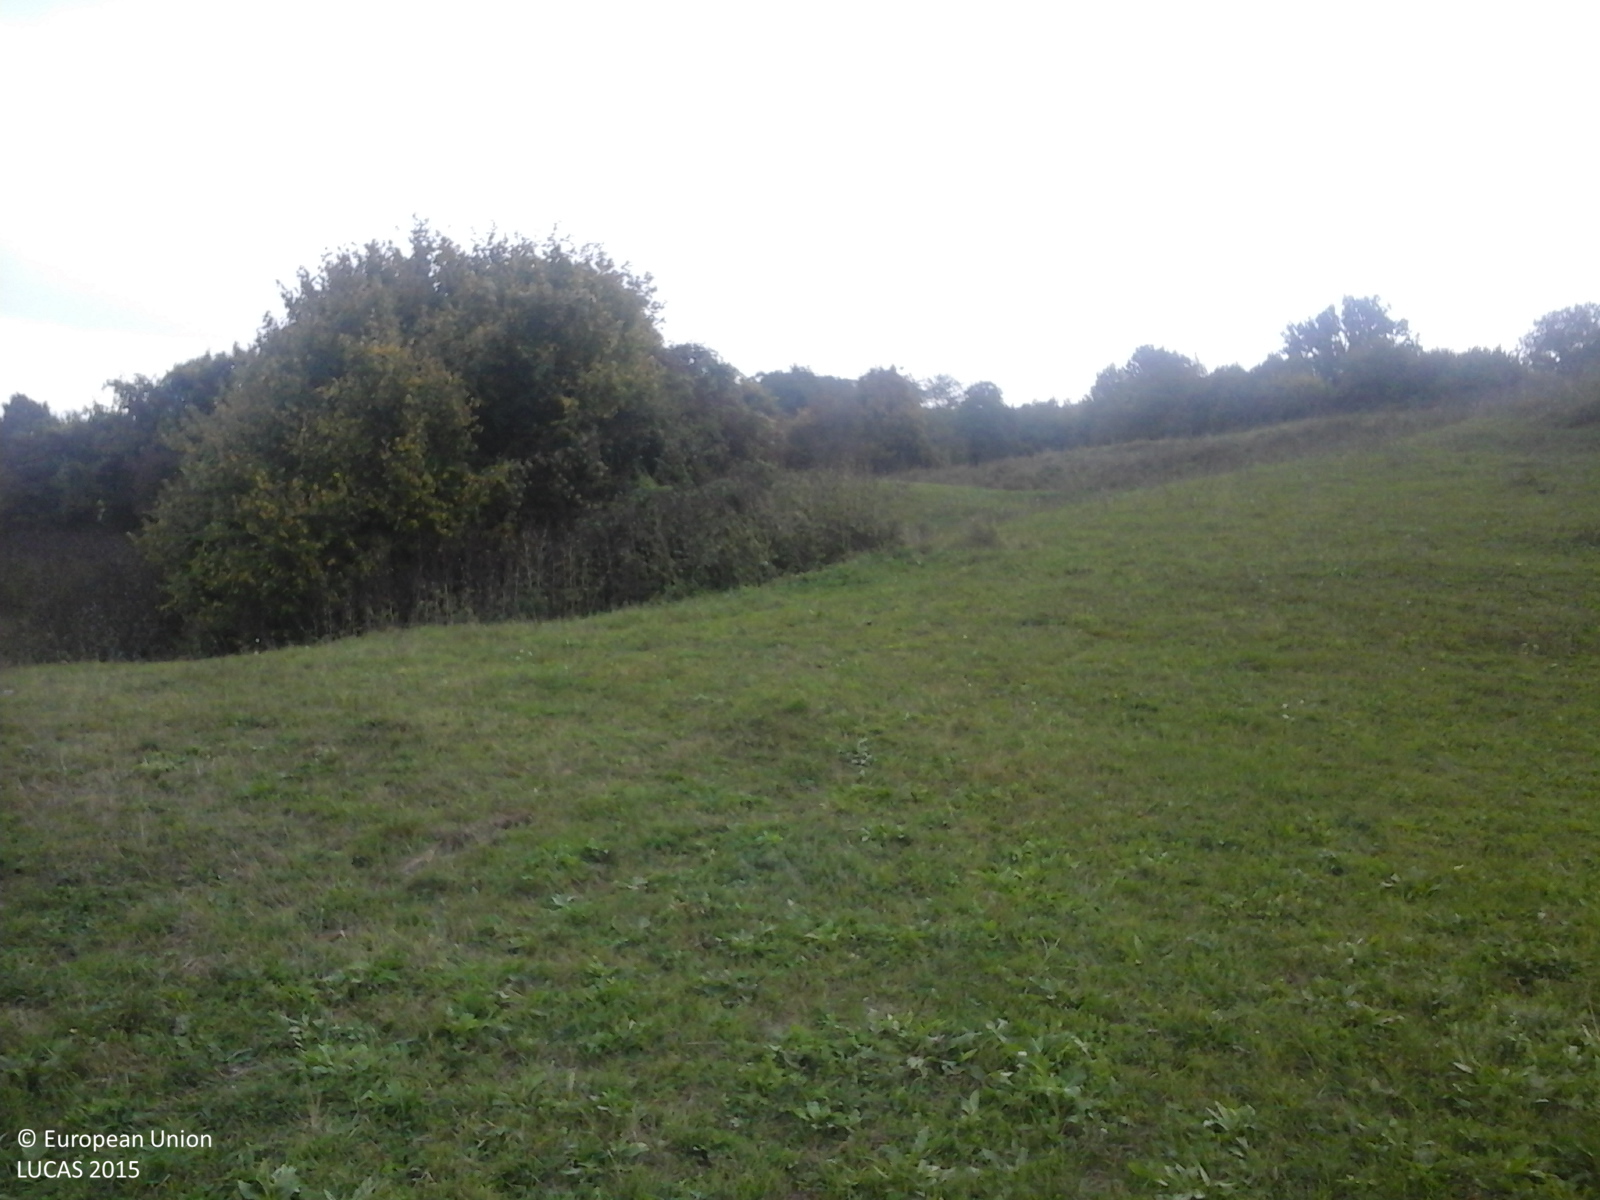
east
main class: Grassland
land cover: Grassland without tree/shrub cover
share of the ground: > 75 %
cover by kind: herbaceous plants 100 %
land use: Agriculture (excluding fallow land and kitchen gardens)
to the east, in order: Grassland without tree/shrub cover; Broadleaved woodland; Grassland without tree/shrub cover; Spontaneously vegetated surfaces; Tracks; Grassland with sparse tree/shrub cover; Broadleaved woodland
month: October
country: RO
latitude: 46.5624
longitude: 25.0354
